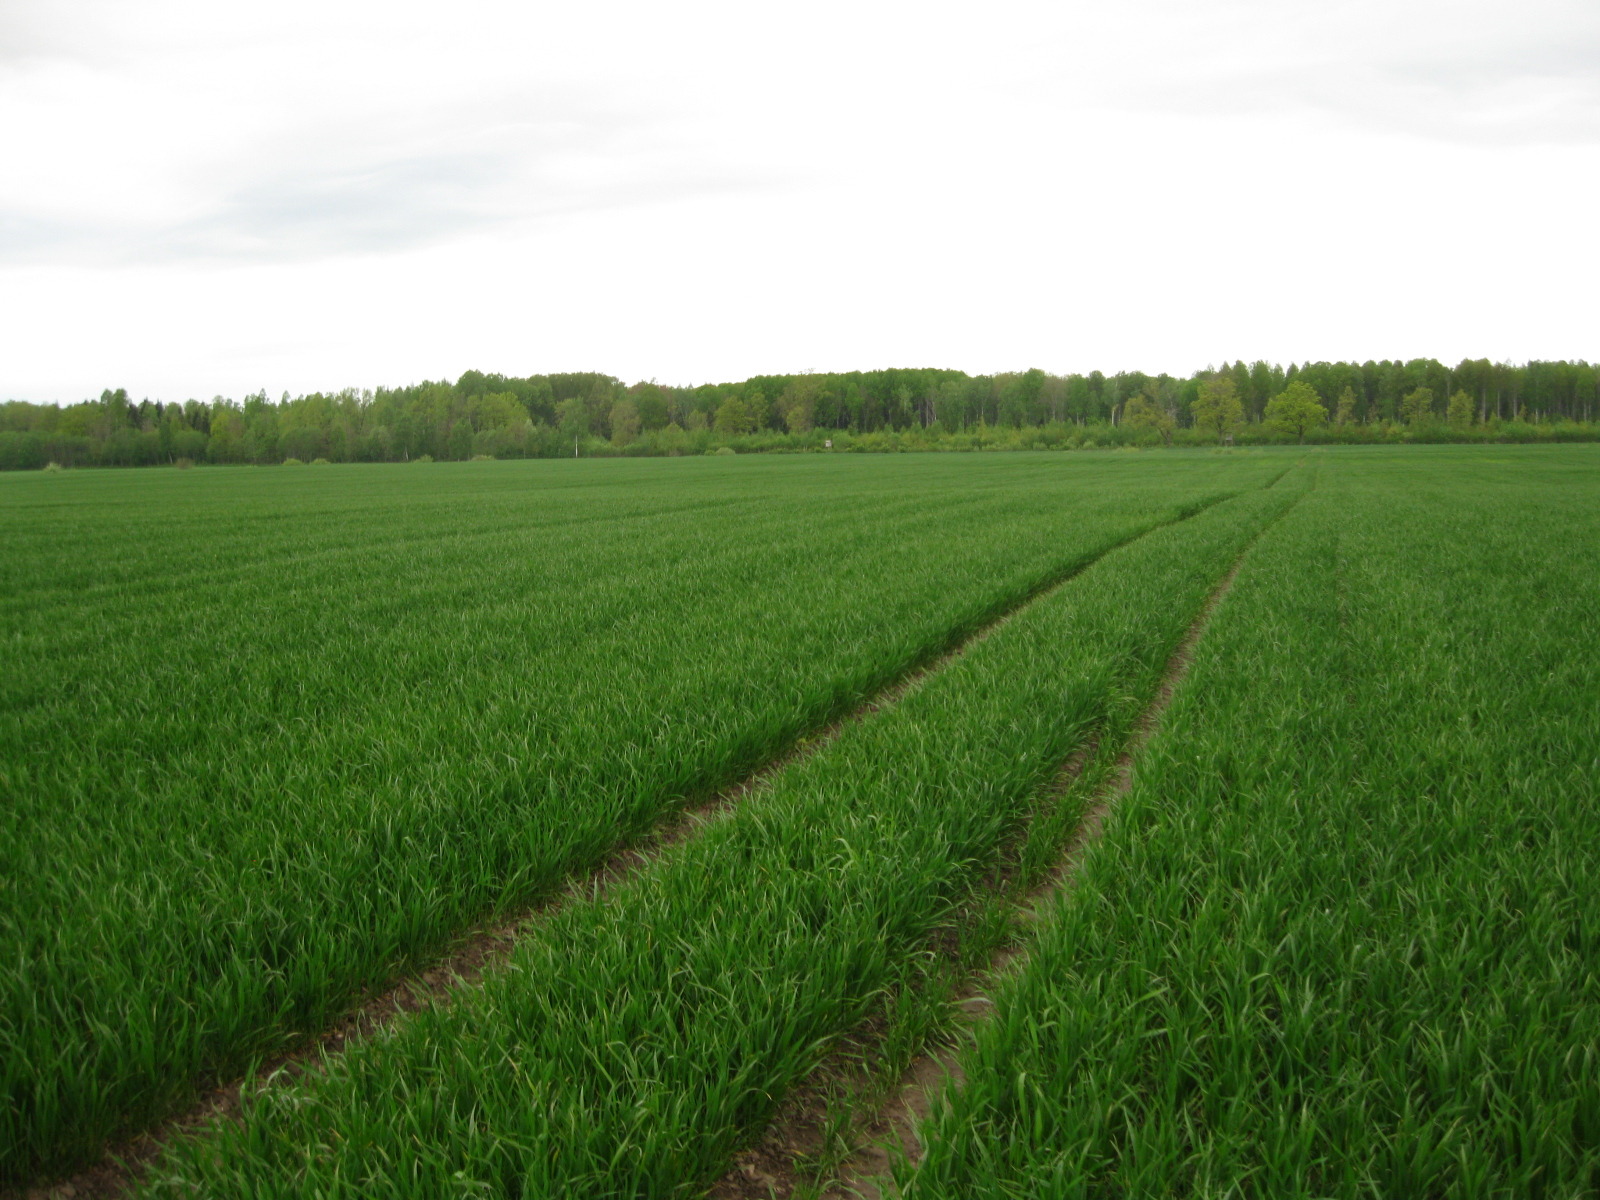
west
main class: Cropland
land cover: Common wheat
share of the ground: > 75 %
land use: Agriculture (excluding fallow land and kitchen gardens)
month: May
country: LT
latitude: 56.2453
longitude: 23.4201
